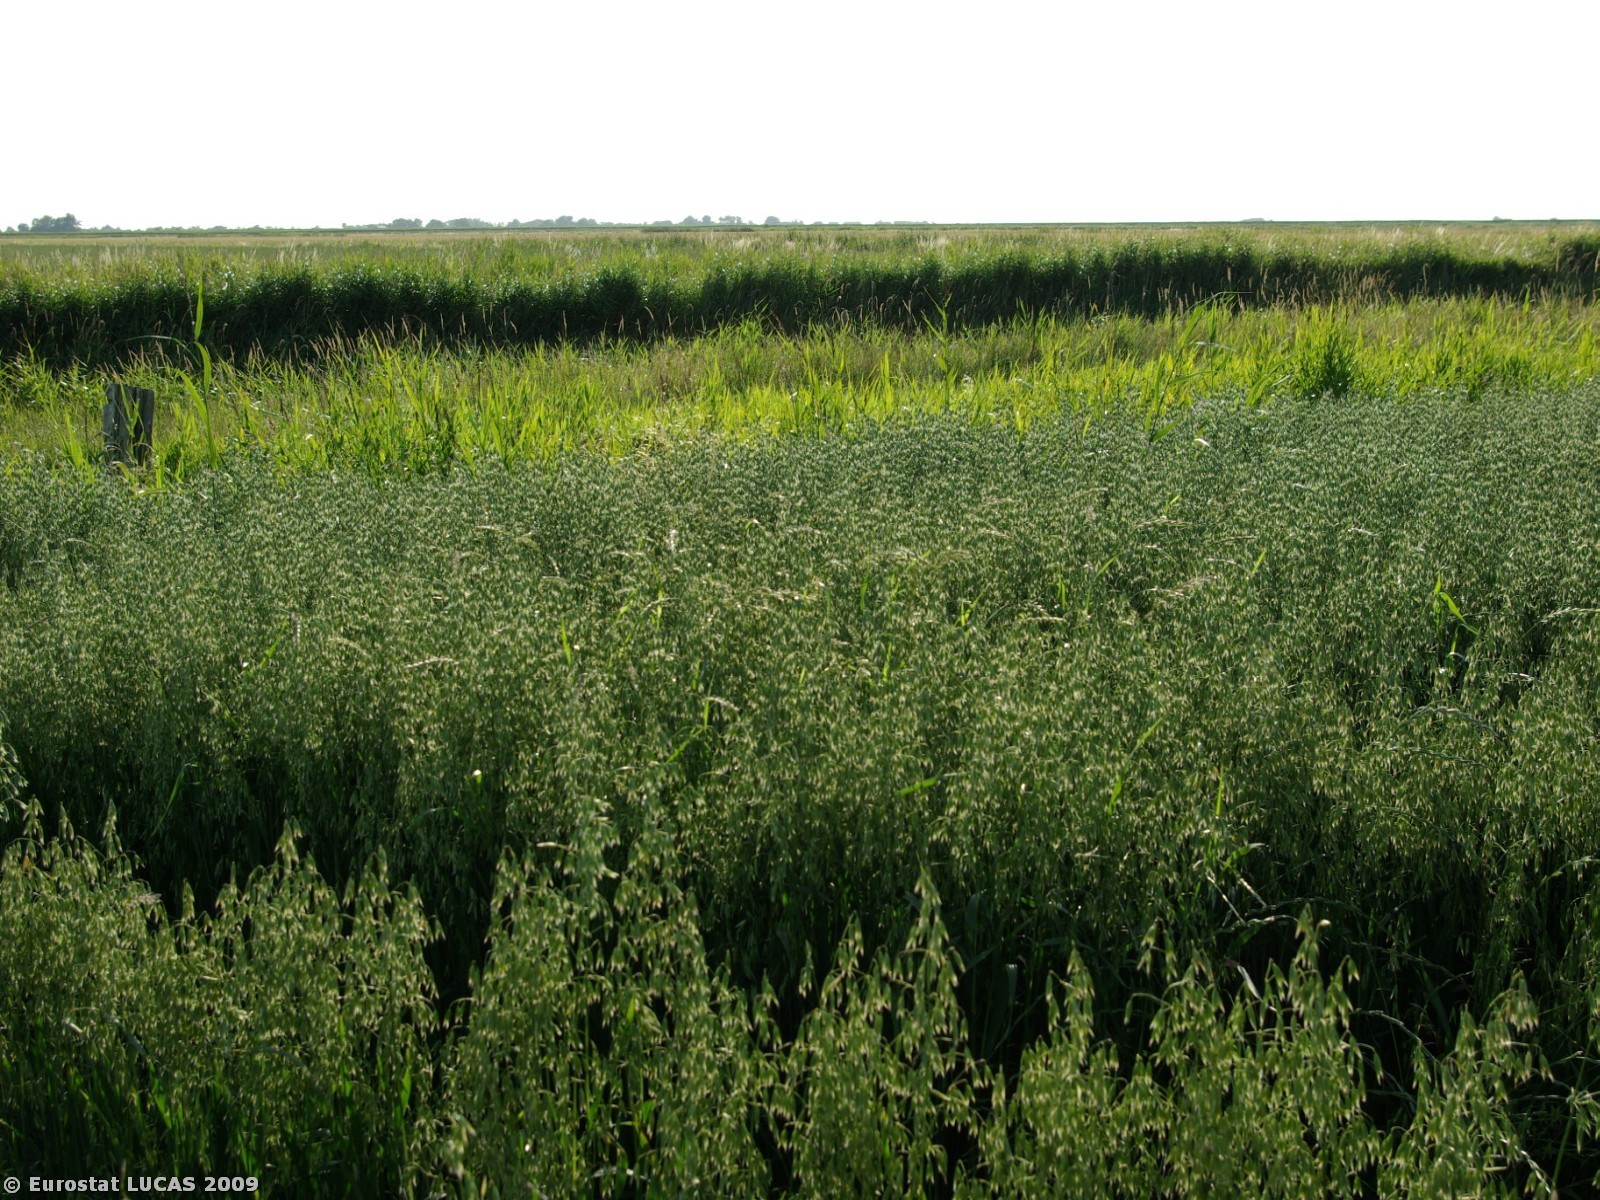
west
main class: Cropland
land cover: Oats
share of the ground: > 75 %
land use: Agriculture (excluding fallow land and kitchen gardens)
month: July
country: DK
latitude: 54.9052
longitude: 8.7376
